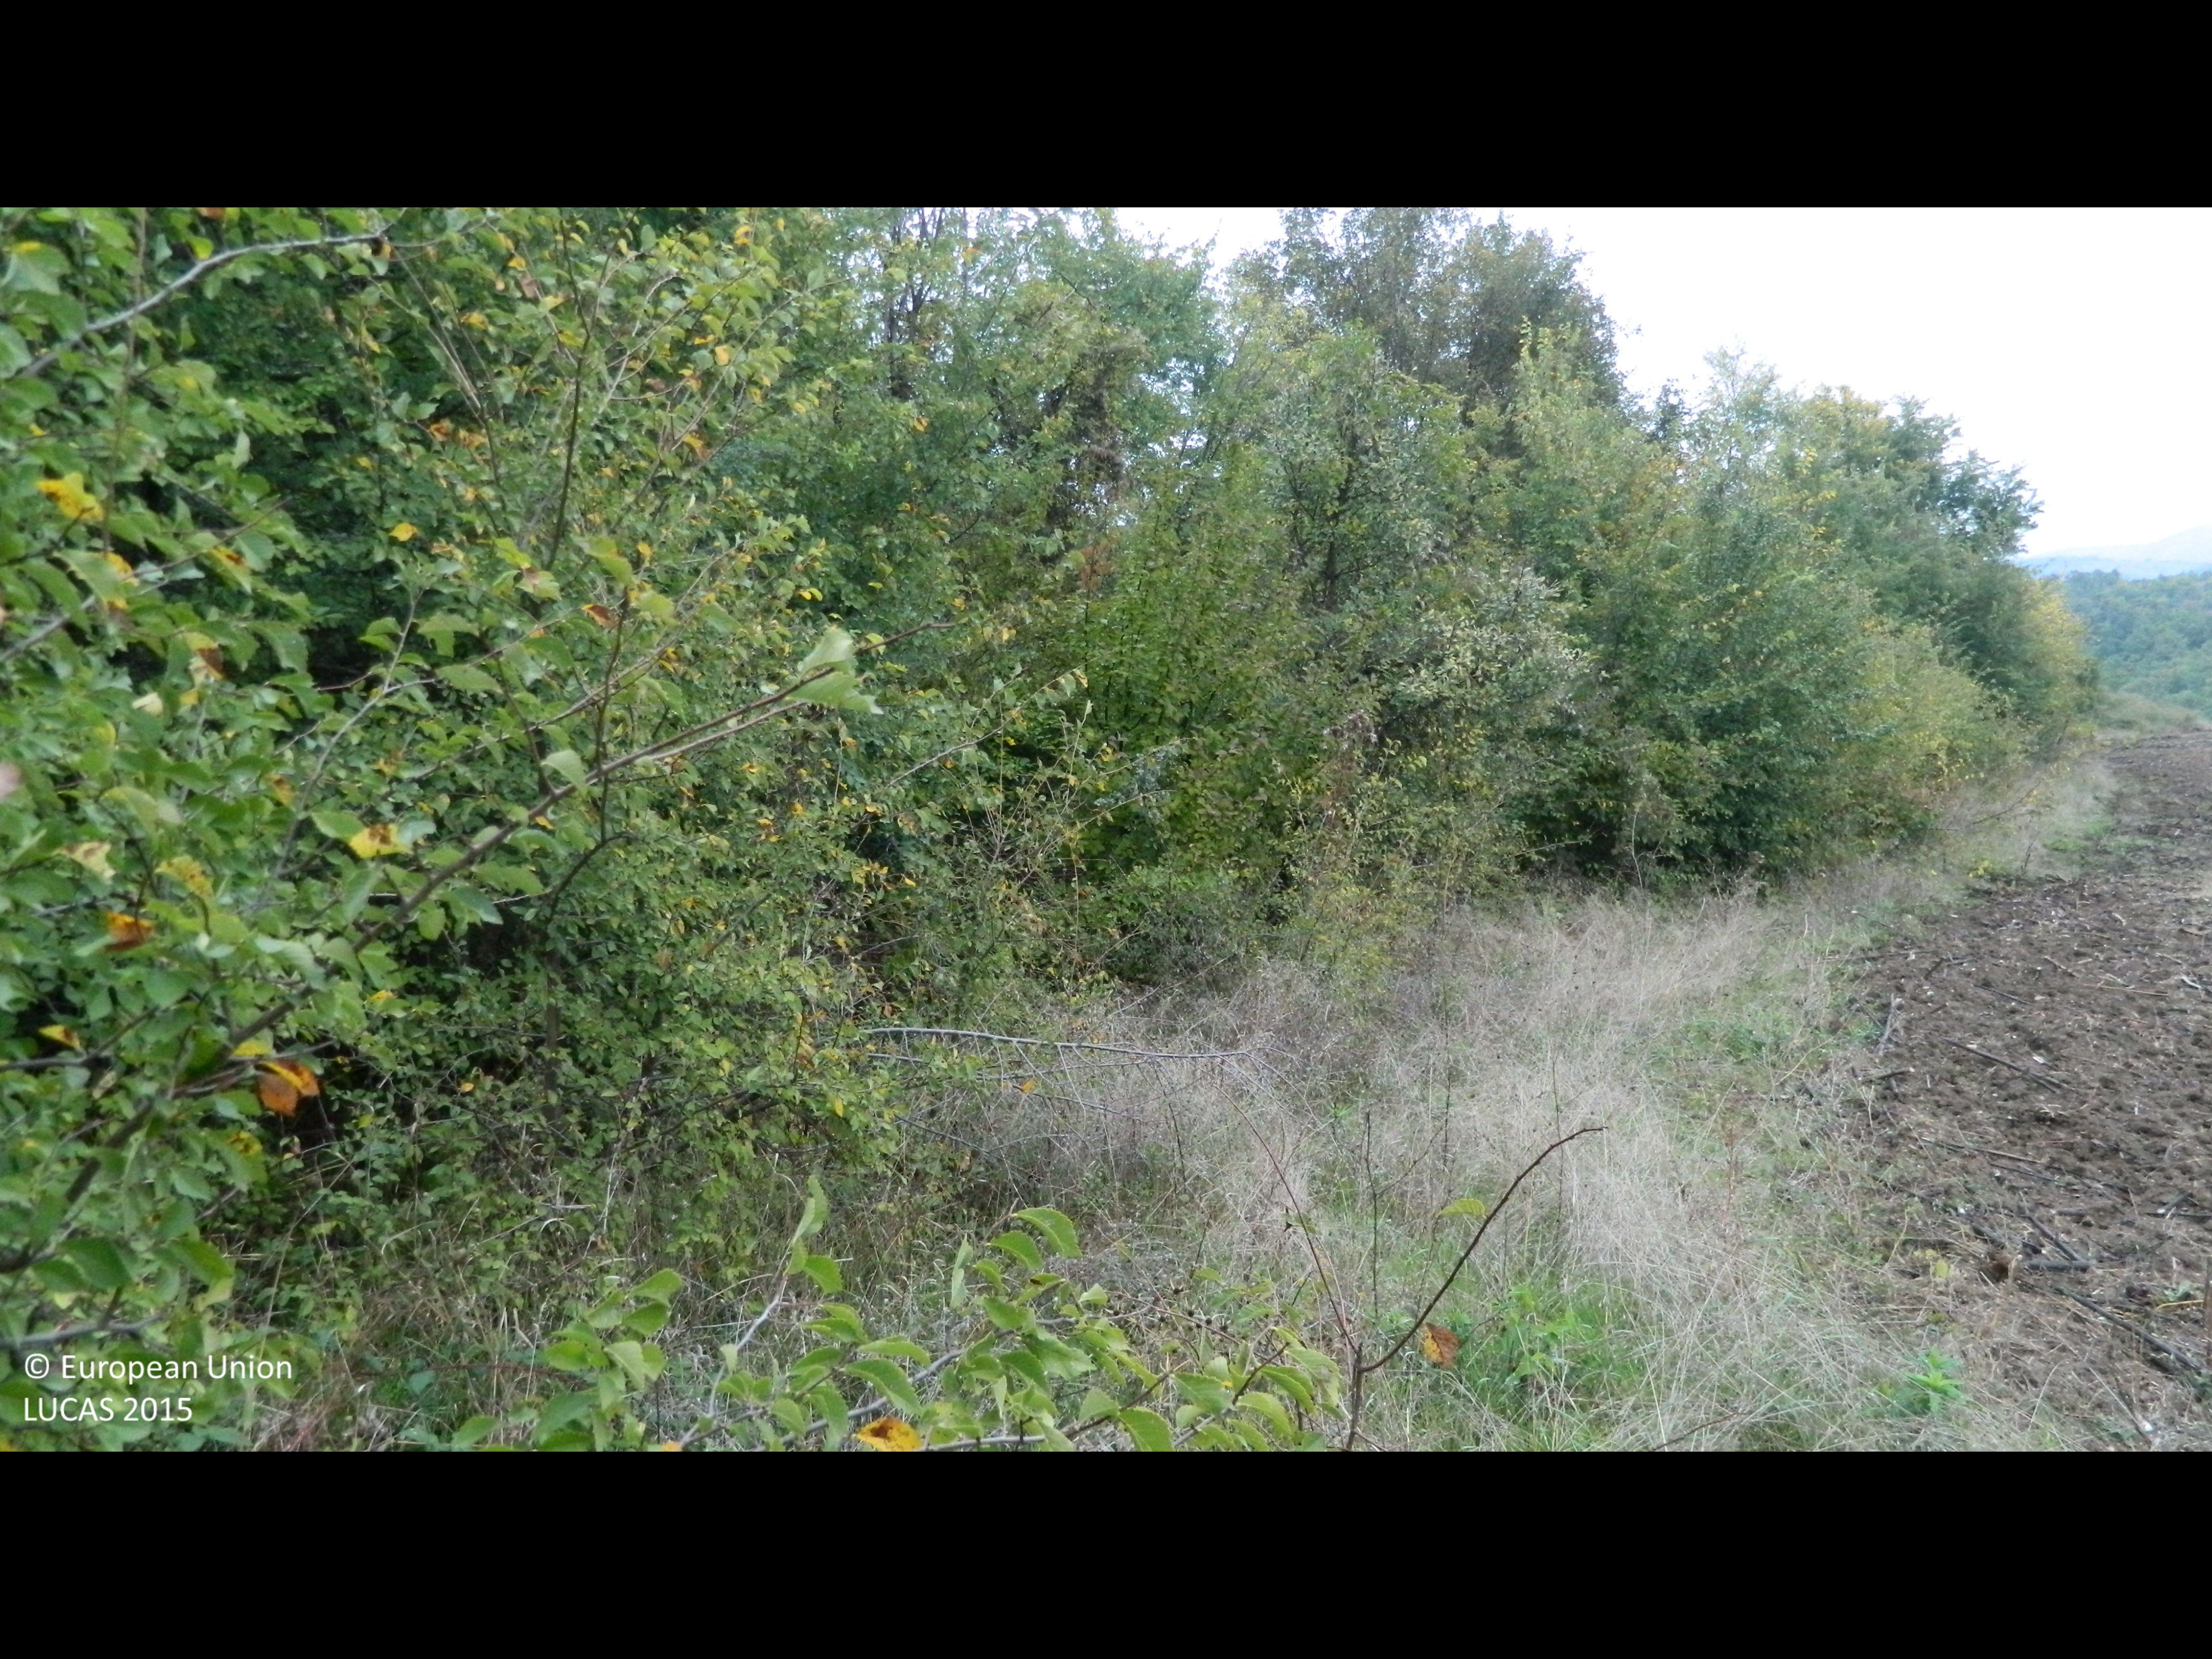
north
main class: Shrubland
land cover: Shrubland with sparse tree cover
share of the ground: > 75 %
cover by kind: shrubs 90 %, broadleaved forest trees 5 %, herbaceous plants 5 %
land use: Semi-natural and natural areas not in use
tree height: > 5 m
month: October
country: BG
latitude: 41.7979
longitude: 25.4038
